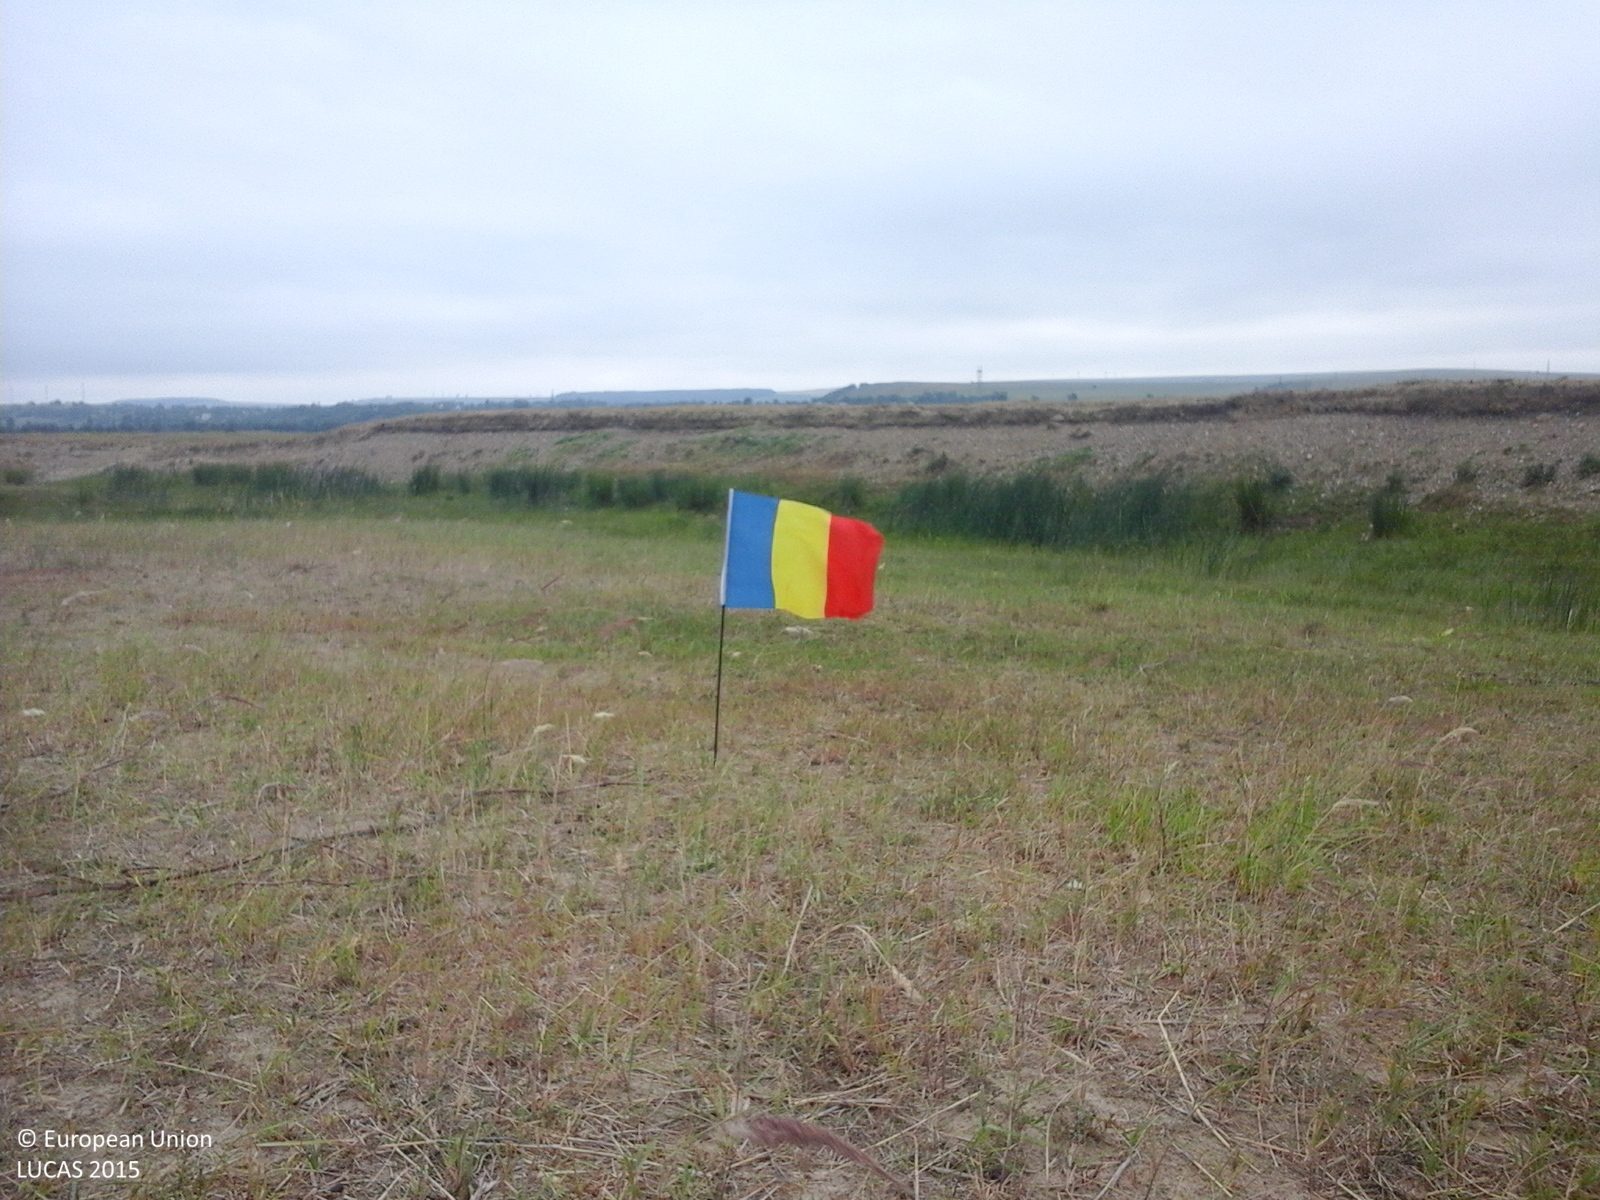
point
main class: Grassland
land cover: Grassland without tree/shrub cover
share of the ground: 25 - 50 %
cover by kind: herbaceous plants 100 %
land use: Agriculture (excluding fallow land and kitchen gardens)
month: June
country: RO
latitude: 47.1314
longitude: 26.6354
